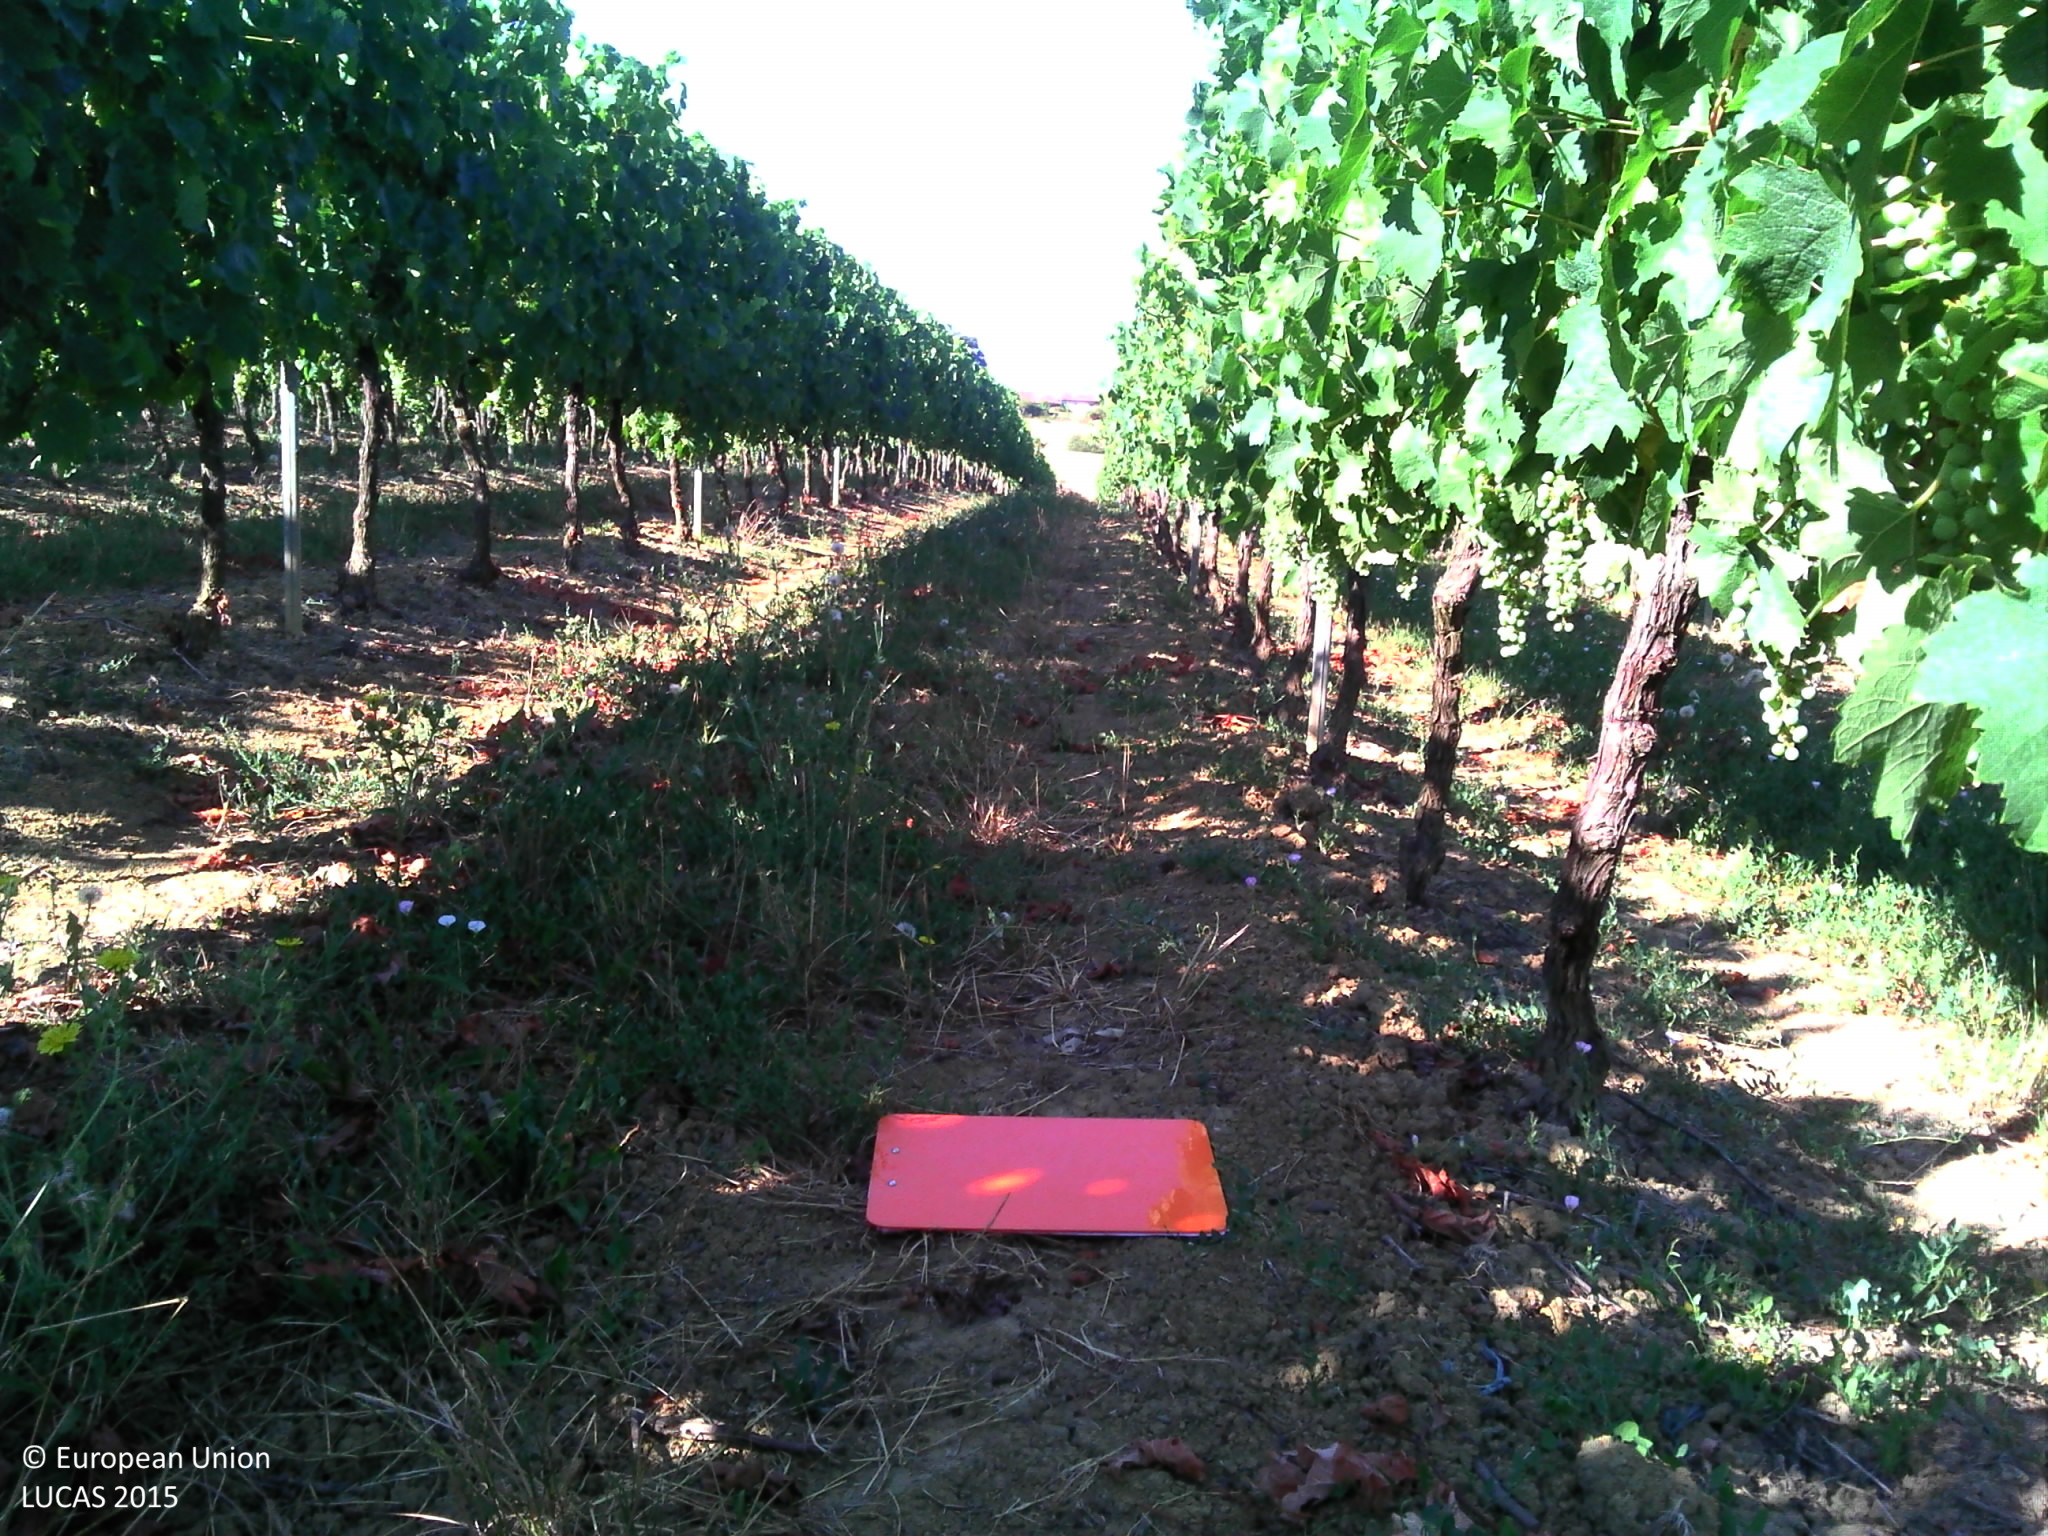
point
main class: Cropland
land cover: Vineyards
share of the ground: 10 - 25 %
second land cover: Grassland without tree/shrub cover
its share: 10 - 25 %
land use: Agriculture (excluding fallow land and kitchen gardens)
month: July
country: FR
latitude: 44.5347
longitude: 0.5414
